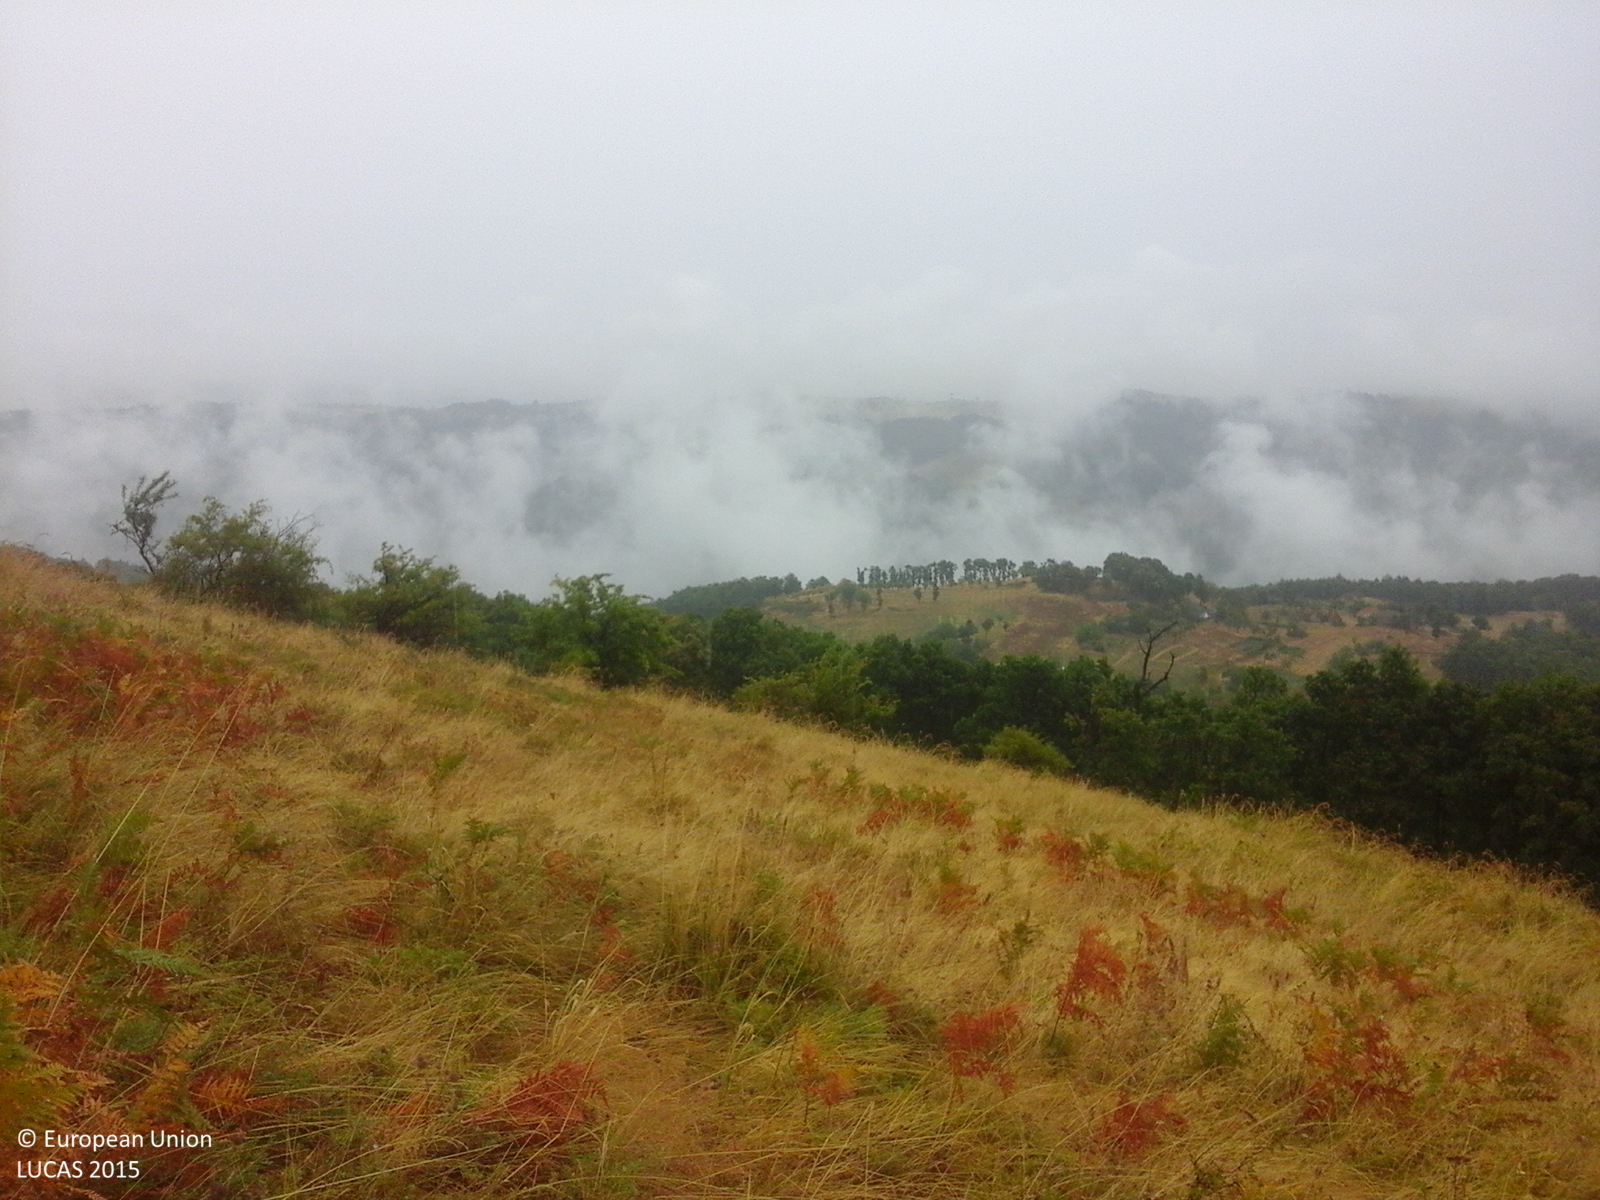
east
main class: Grassland
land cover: Spontaneously vegetated surfaces
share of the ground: > 75 %
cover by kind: herbaceous plants 100 %
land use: Semi-natural and natural areas not in use
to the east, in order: Spontaneously vegetated surfaces; Lines of trees; Grassland without tree/shrub cover; Single bushes/trees; Grassland without tree/shrub cover; Broadleaved woodland
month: August
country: RO
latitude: 44.8666
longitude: 22.5078
